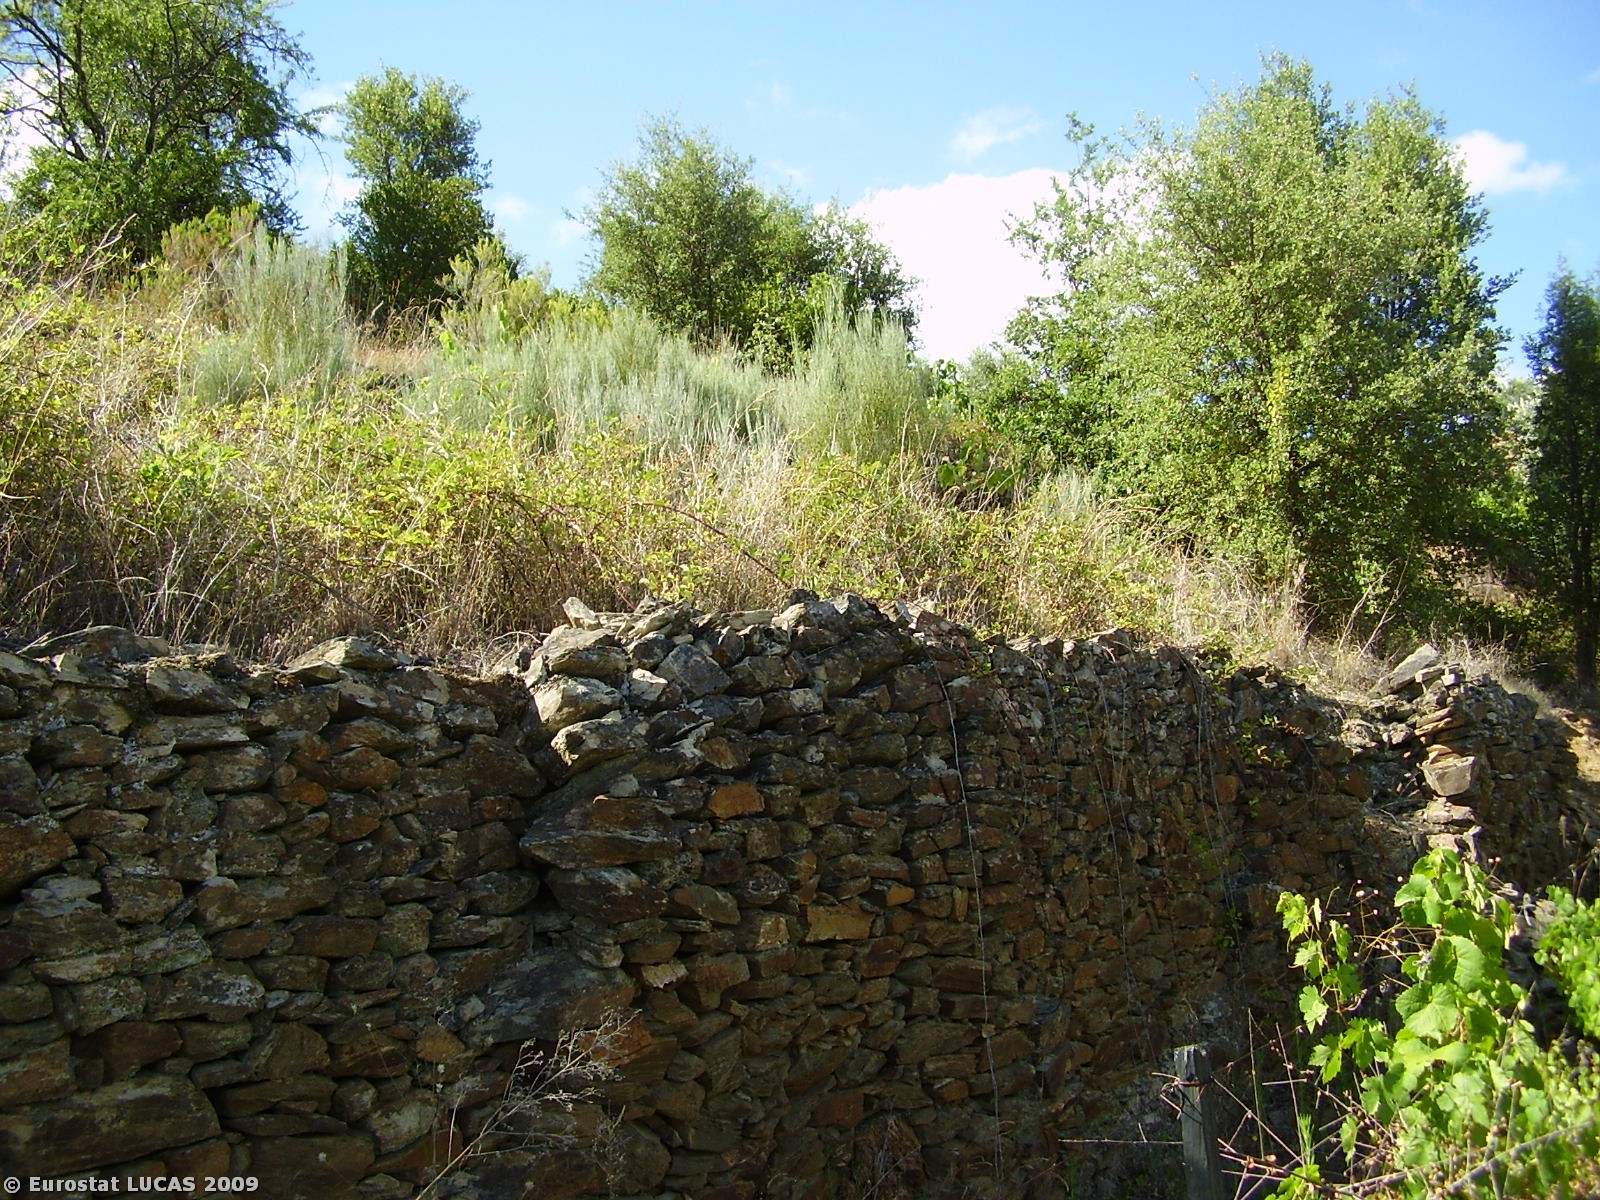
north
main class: Cropland
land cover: Vineyards
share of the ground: < 10 %
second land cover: Spontaneously vegetated surfaces
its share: 10 - 25 %
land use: Agriculture (excluding fallow land and kitchen gardens)
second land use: Unused
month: July
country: PT
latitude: 41.2748
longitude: -7.5426
